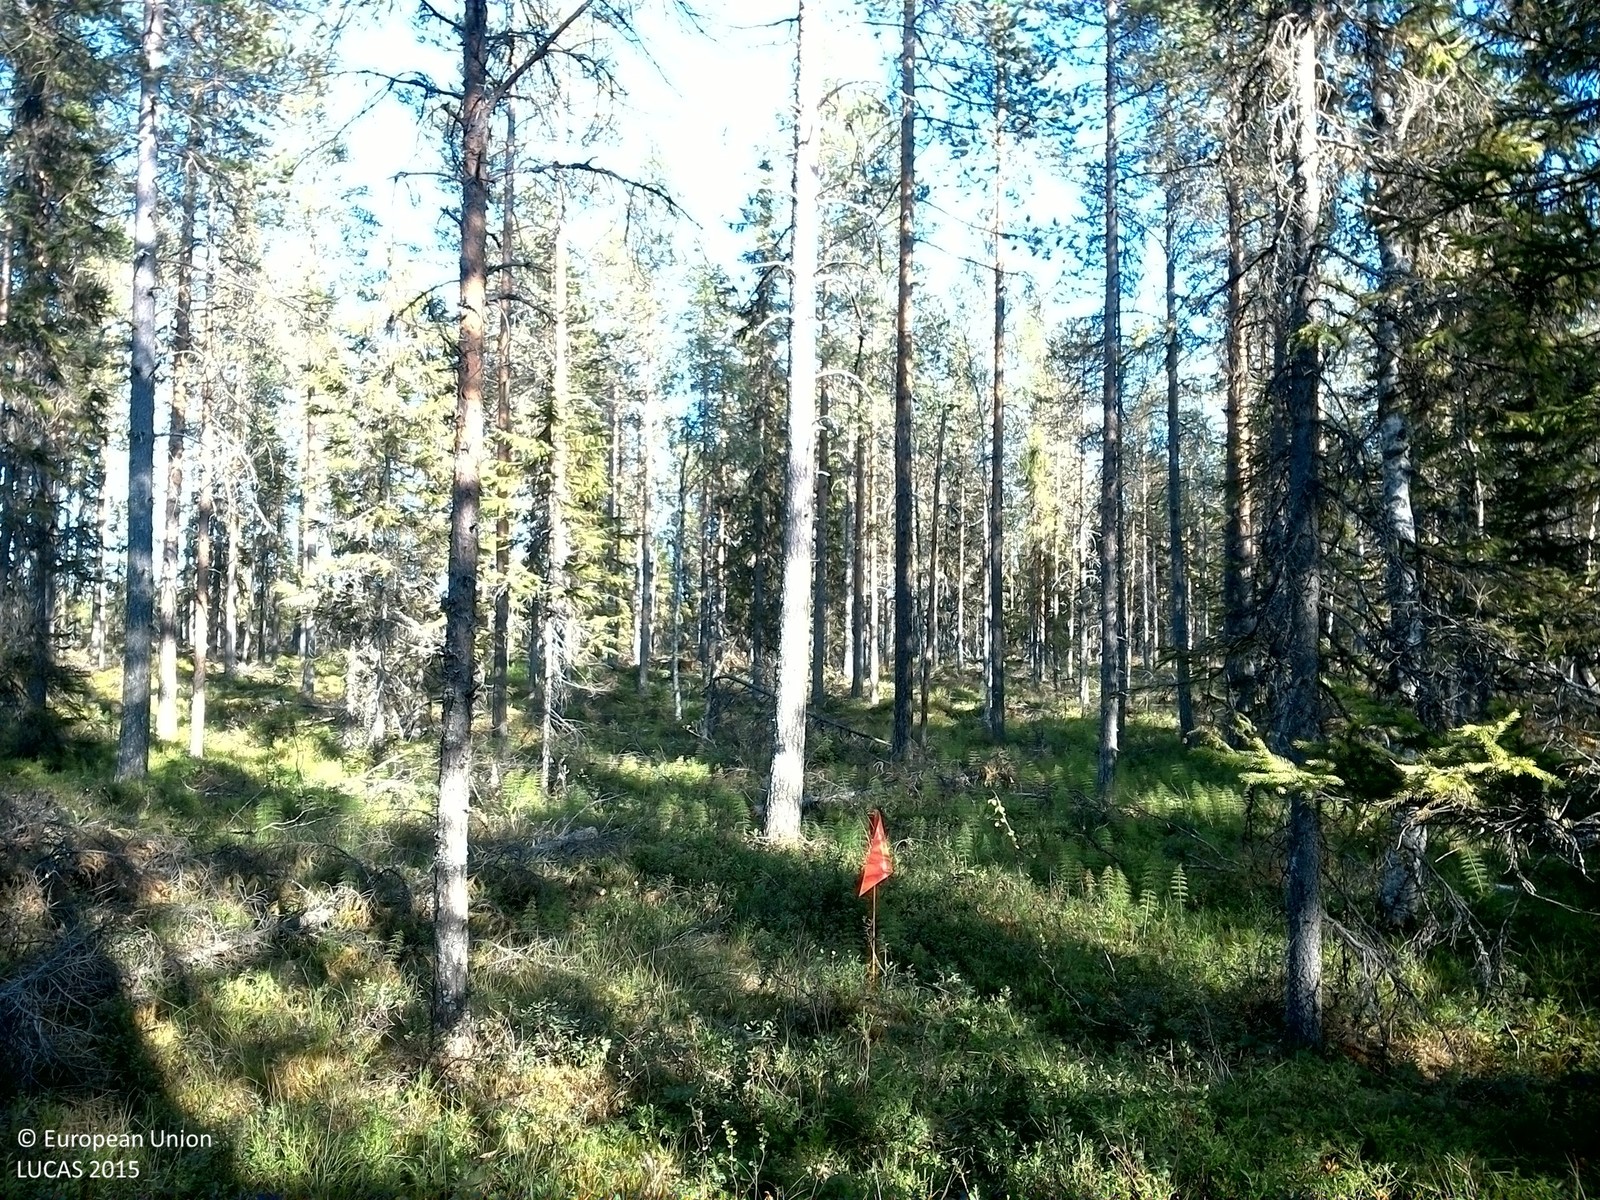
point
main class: Woodland
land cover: Pine dominated coniferous woodland
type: boreal forest
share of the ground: 50 - 75 %
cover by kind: coniferous forest trees 60 %, shrubs 25 %, broadleaved forest trees 5 %, herbaceous plants 5 %, lichens and mosses 5 %
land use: Forestry
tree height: > 5 m
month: August
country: SE
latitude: 63.6918
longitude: 17.5566
